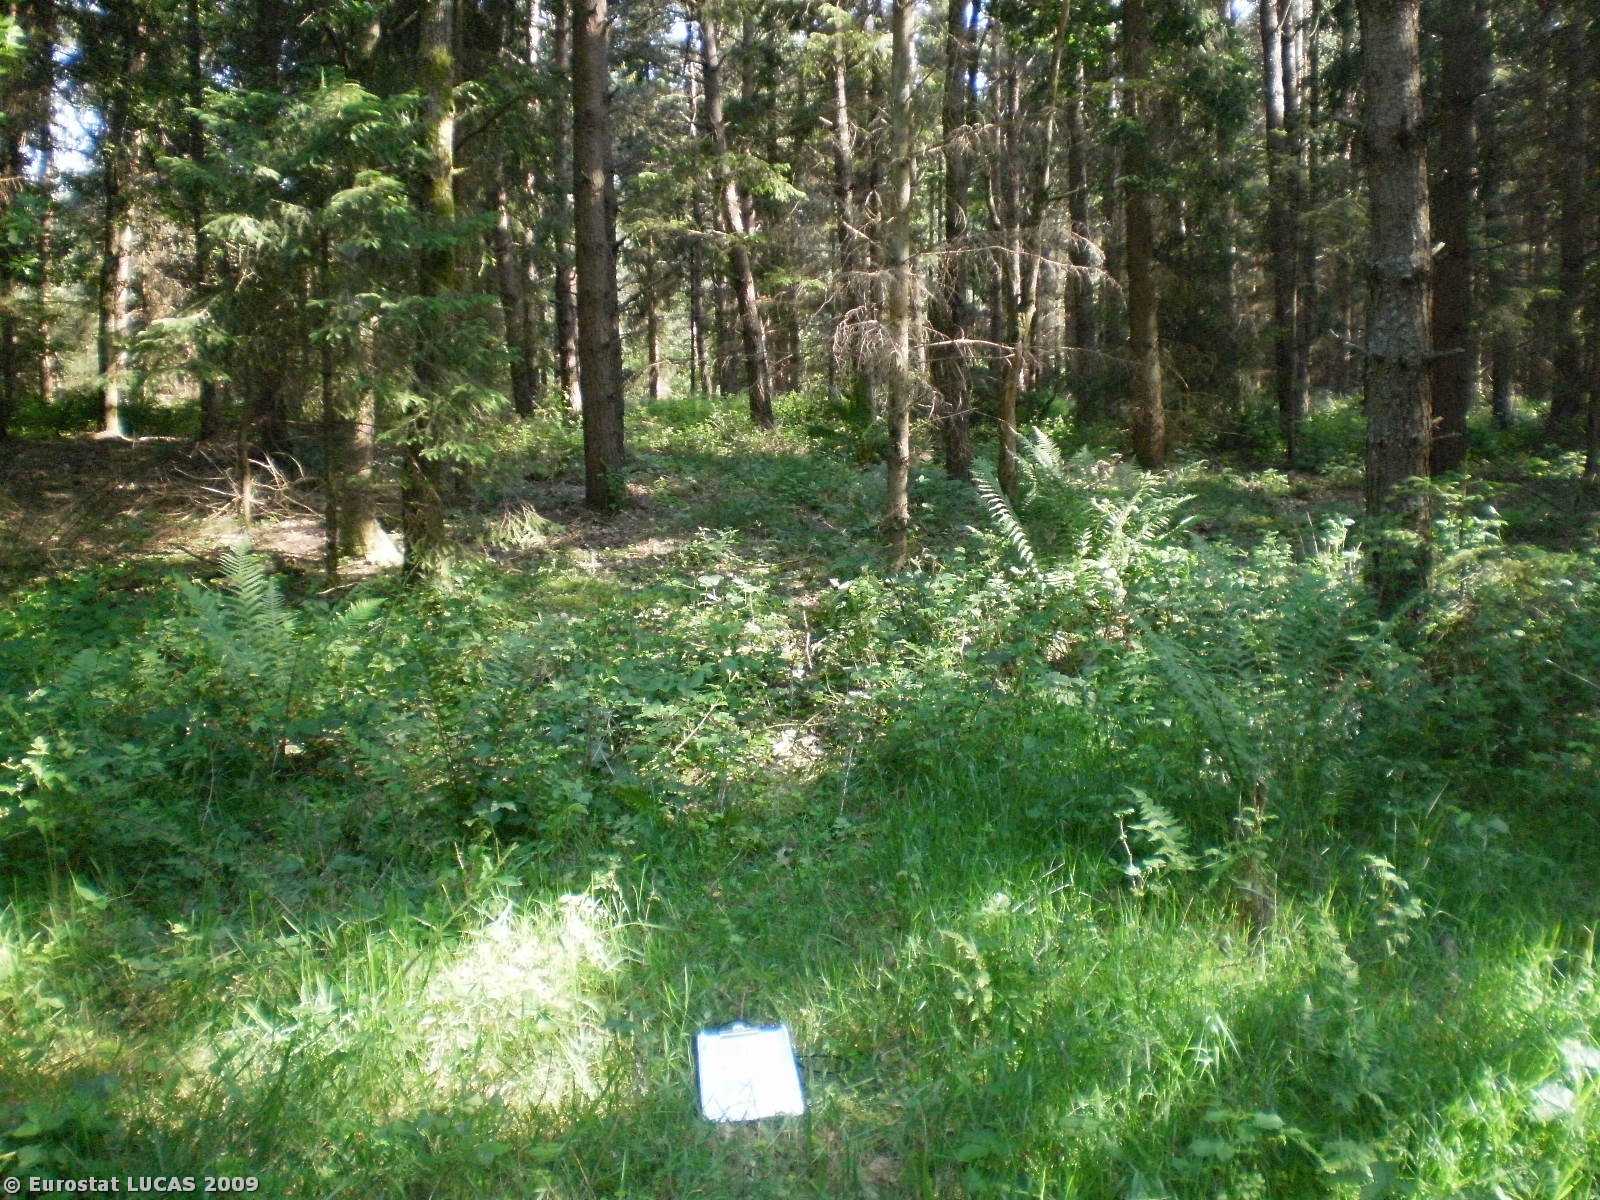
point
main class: Woodland
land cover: Coniferous woodland
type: hemiboreal forest and nemoral coniferous forest and mixed broadleaved-coniferous forest
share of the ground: > 75 %
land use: Forestry
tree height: > 5 m
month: June
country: PL
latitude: 54.4271
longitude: 17.3003
